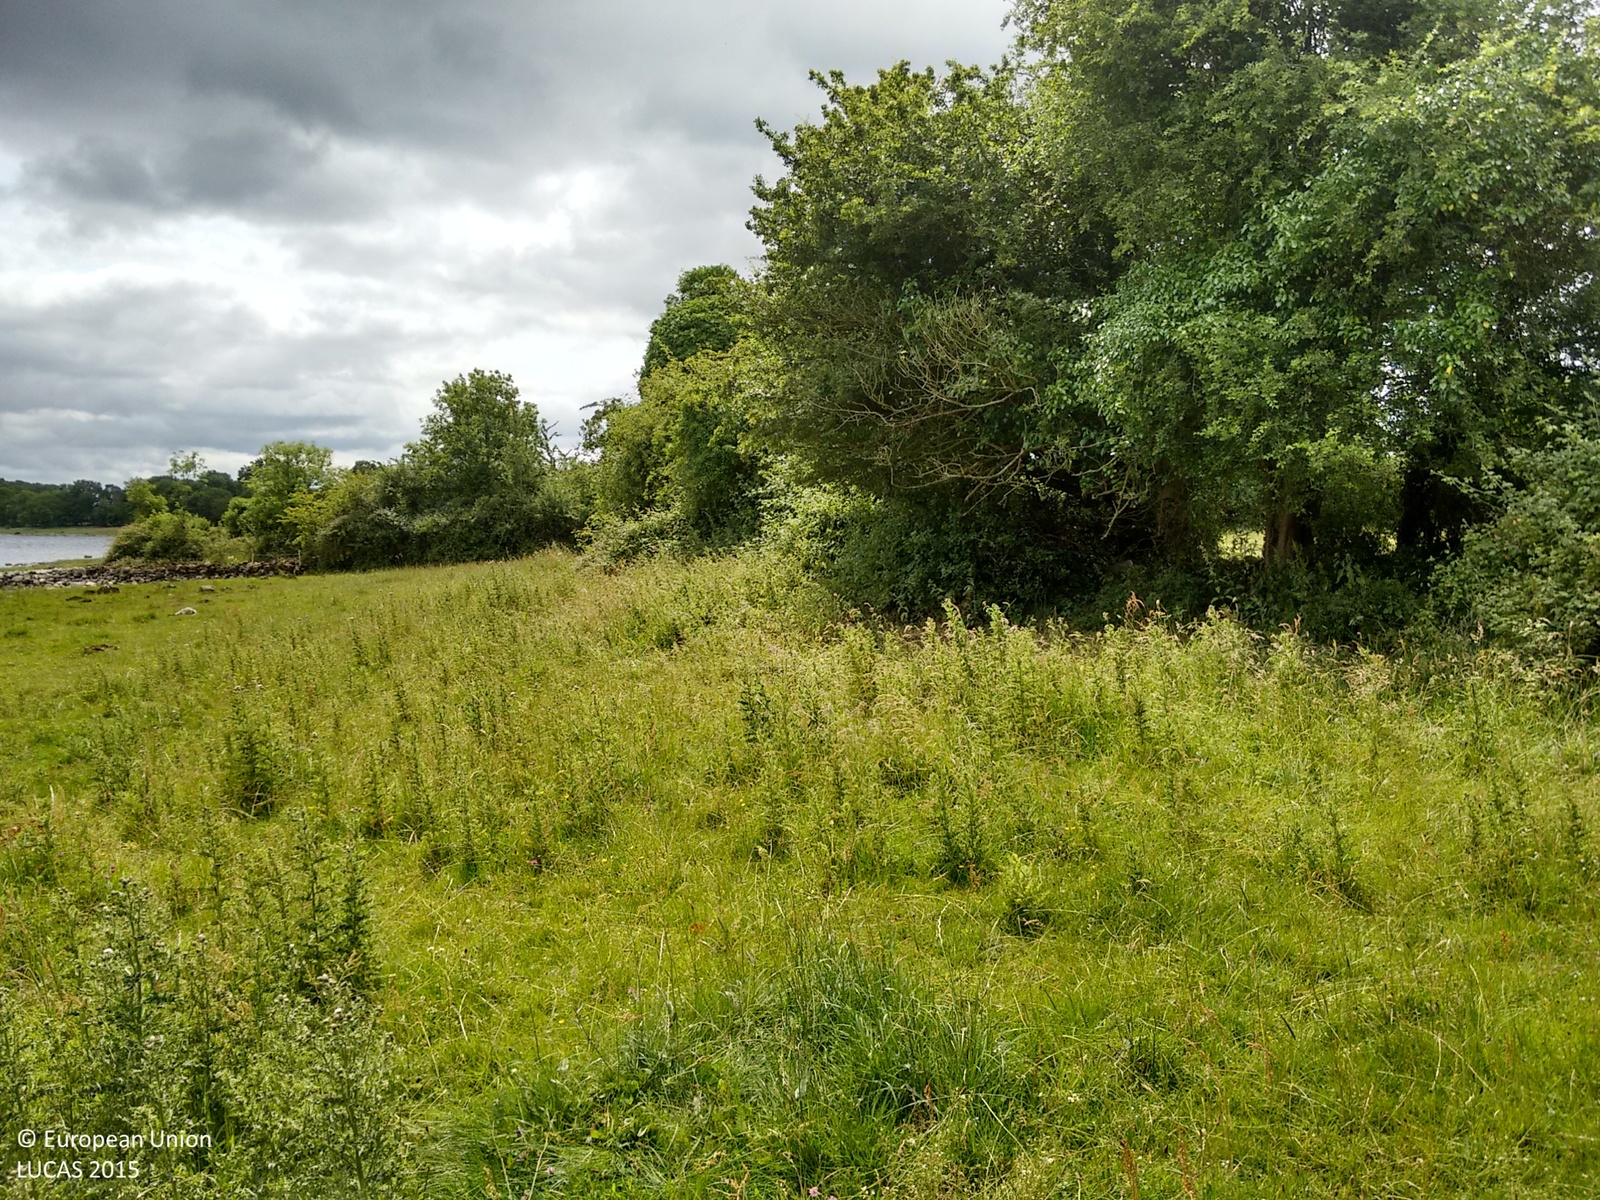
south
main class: Grassland
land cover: Grassland without tree/shrub cover
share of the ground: > 75 %
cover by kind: herbaceous plants 100 %
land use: Agriculture (excluding fallow land and kitchen gardens)
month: July
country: IE
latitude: 53.5497
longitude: -8.0000
